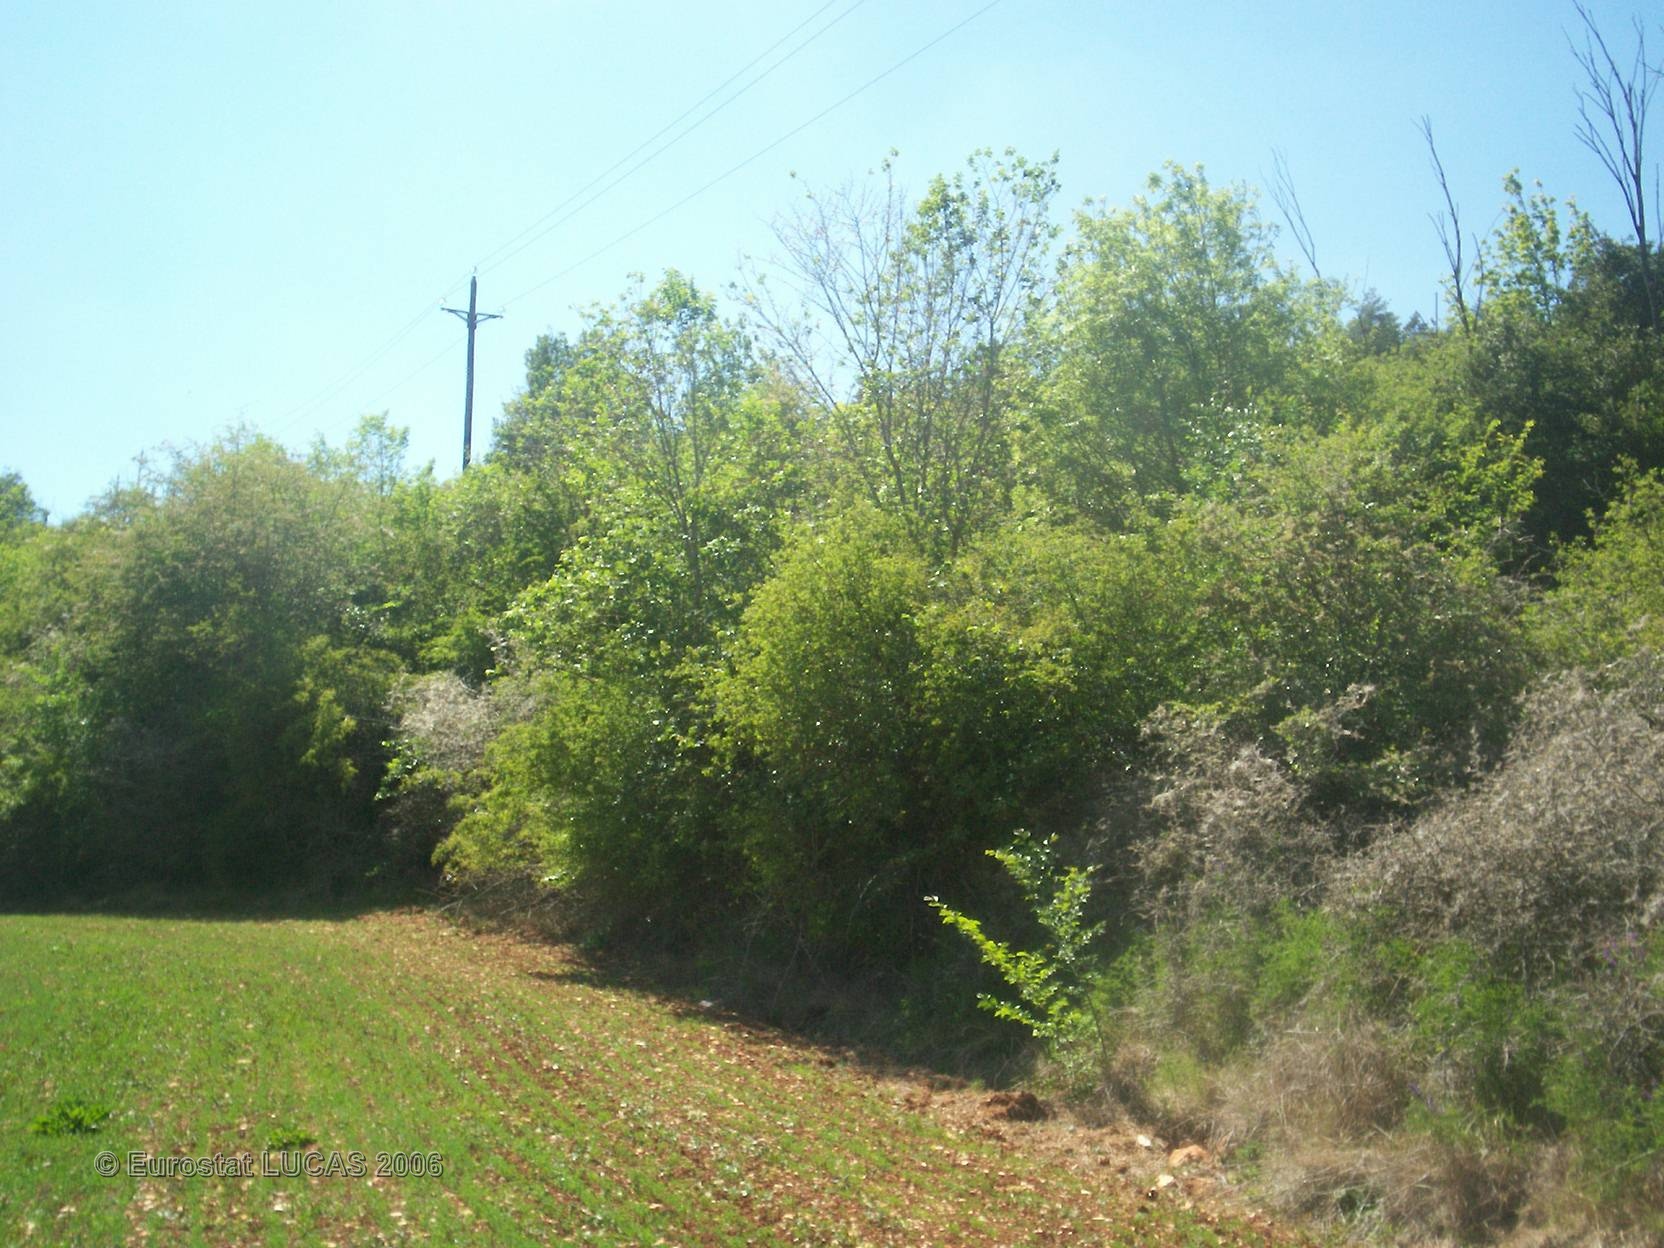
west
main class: Cropland
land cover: Clovers
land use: Agriculture (excluding fallow land and kitchen gardens)
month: June
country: FR
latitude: 44.3000
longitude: 3.3500
